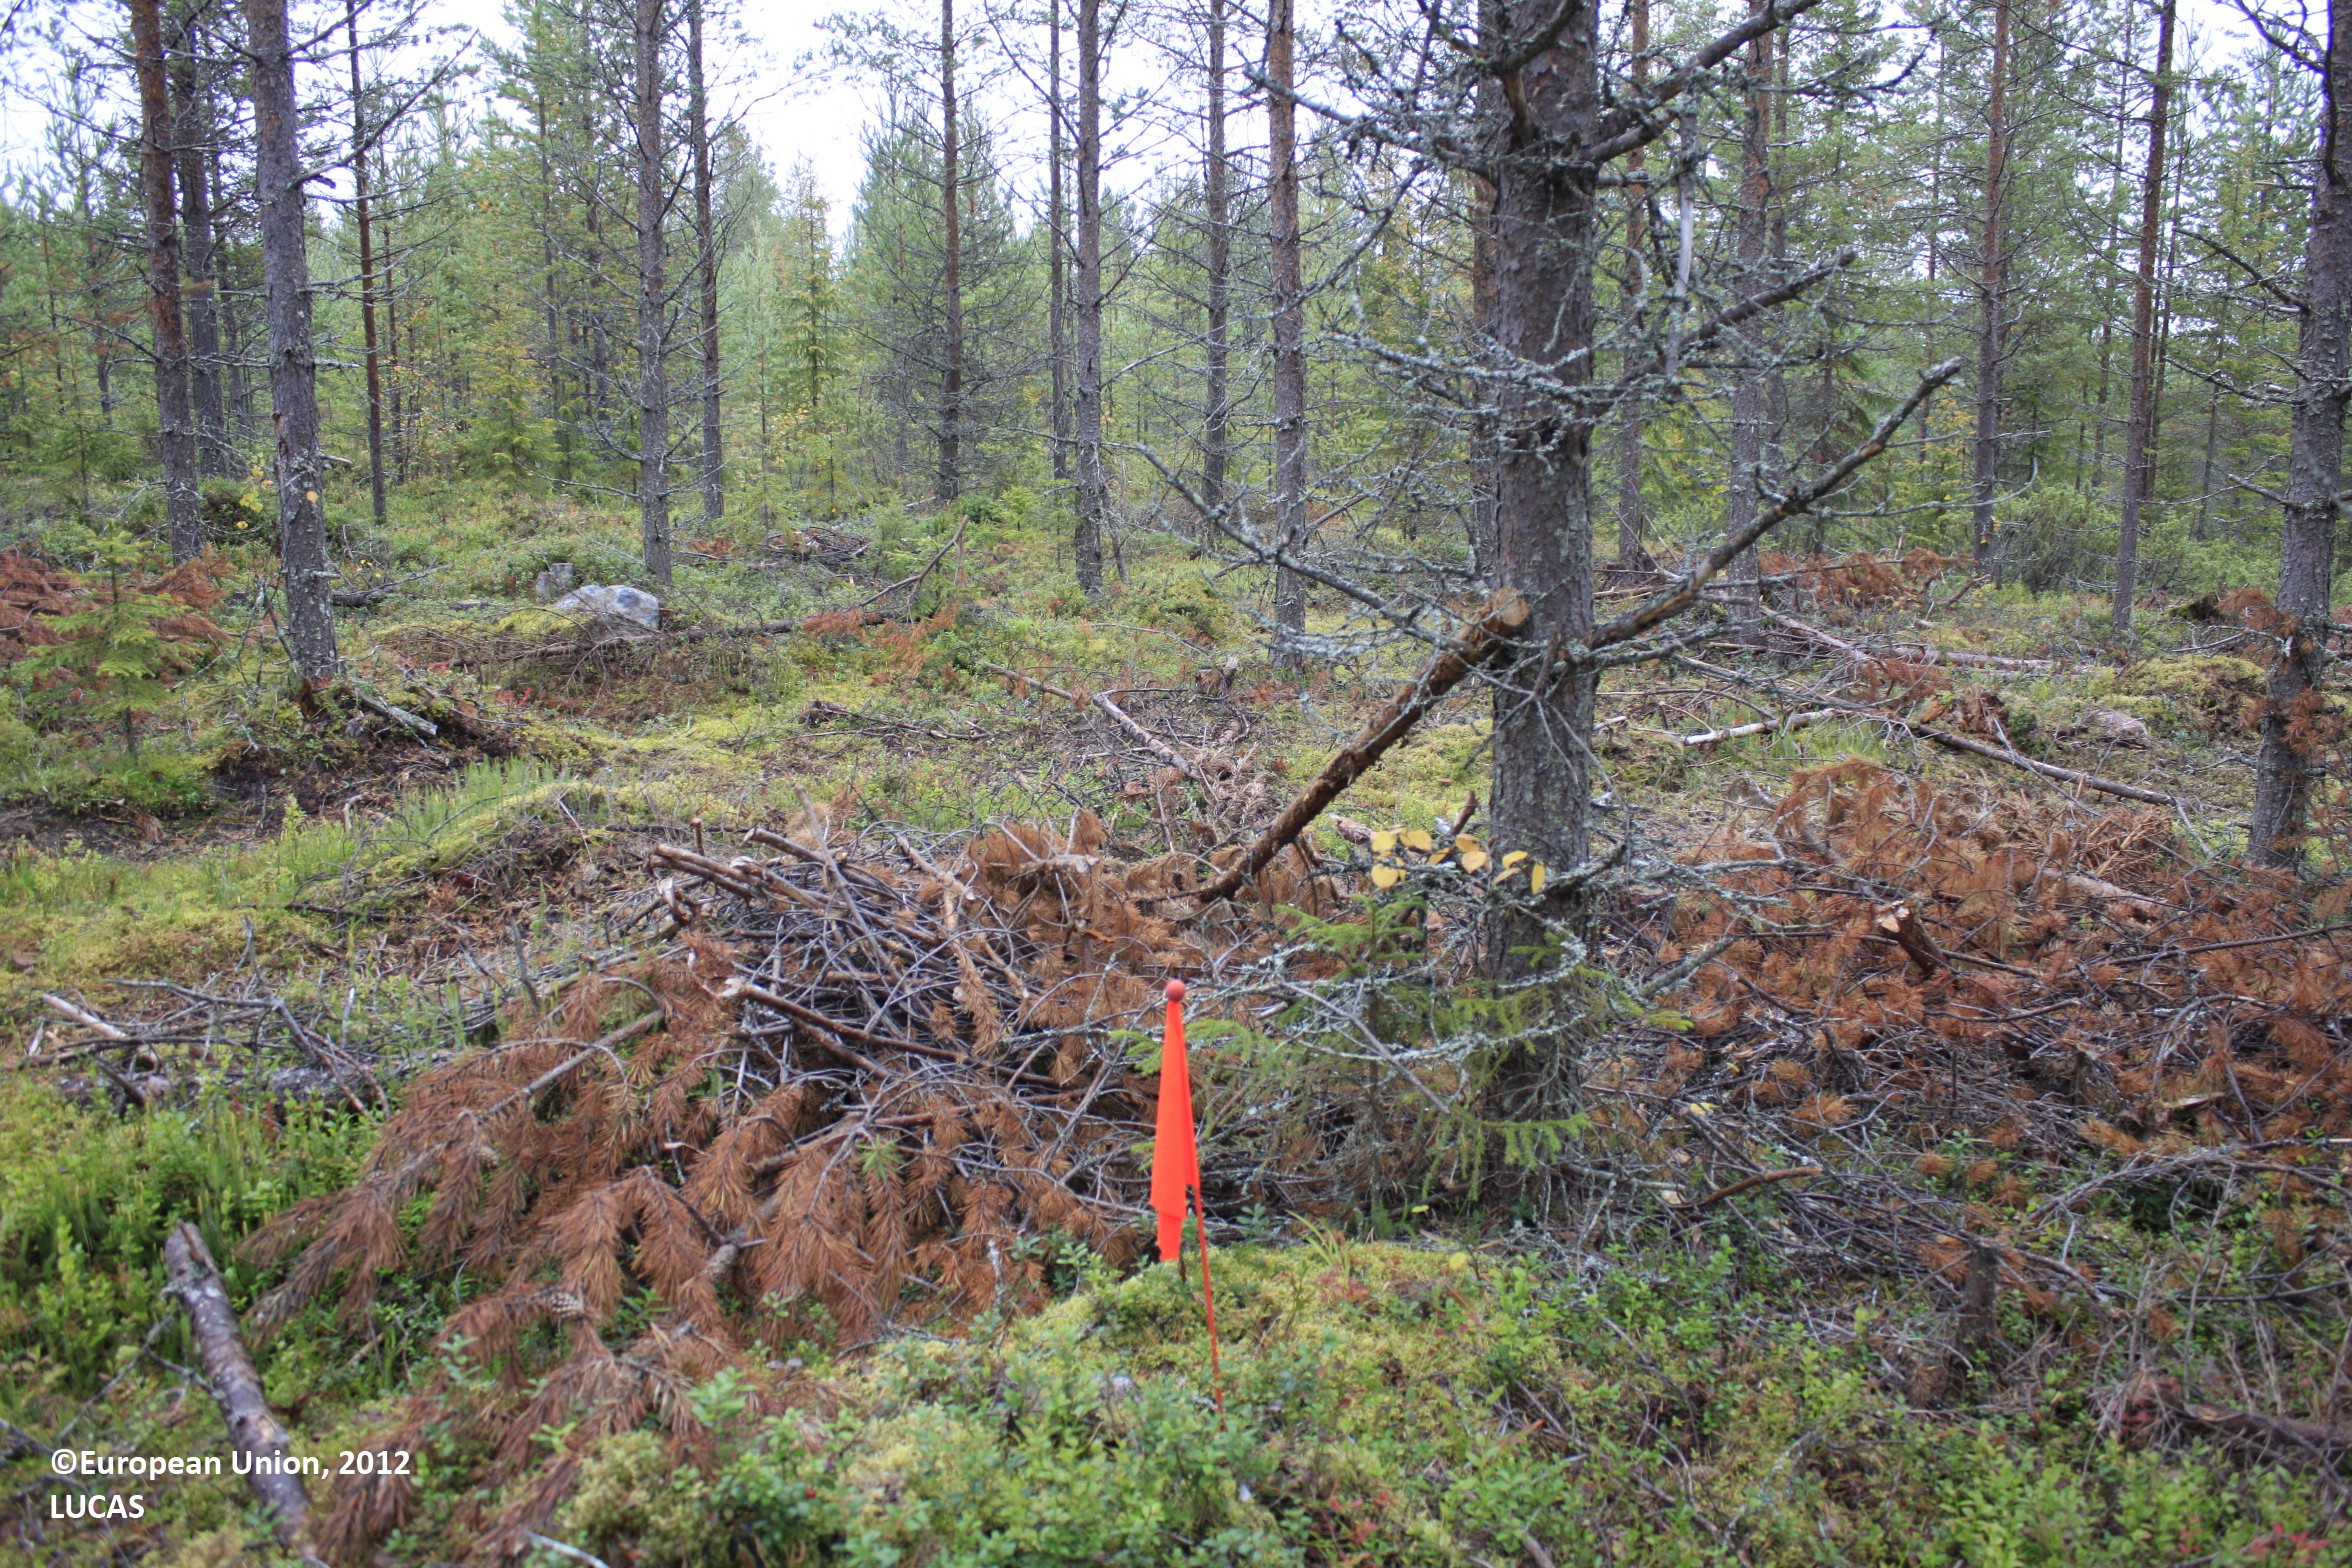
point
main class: Woodland
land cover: Pine dominated coniferous woodland
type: boreal forest
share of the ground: 25 - 50 %
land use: Forestry
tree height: > 5 m
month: September
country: FI
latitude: 65.8503
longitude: 27.1788
